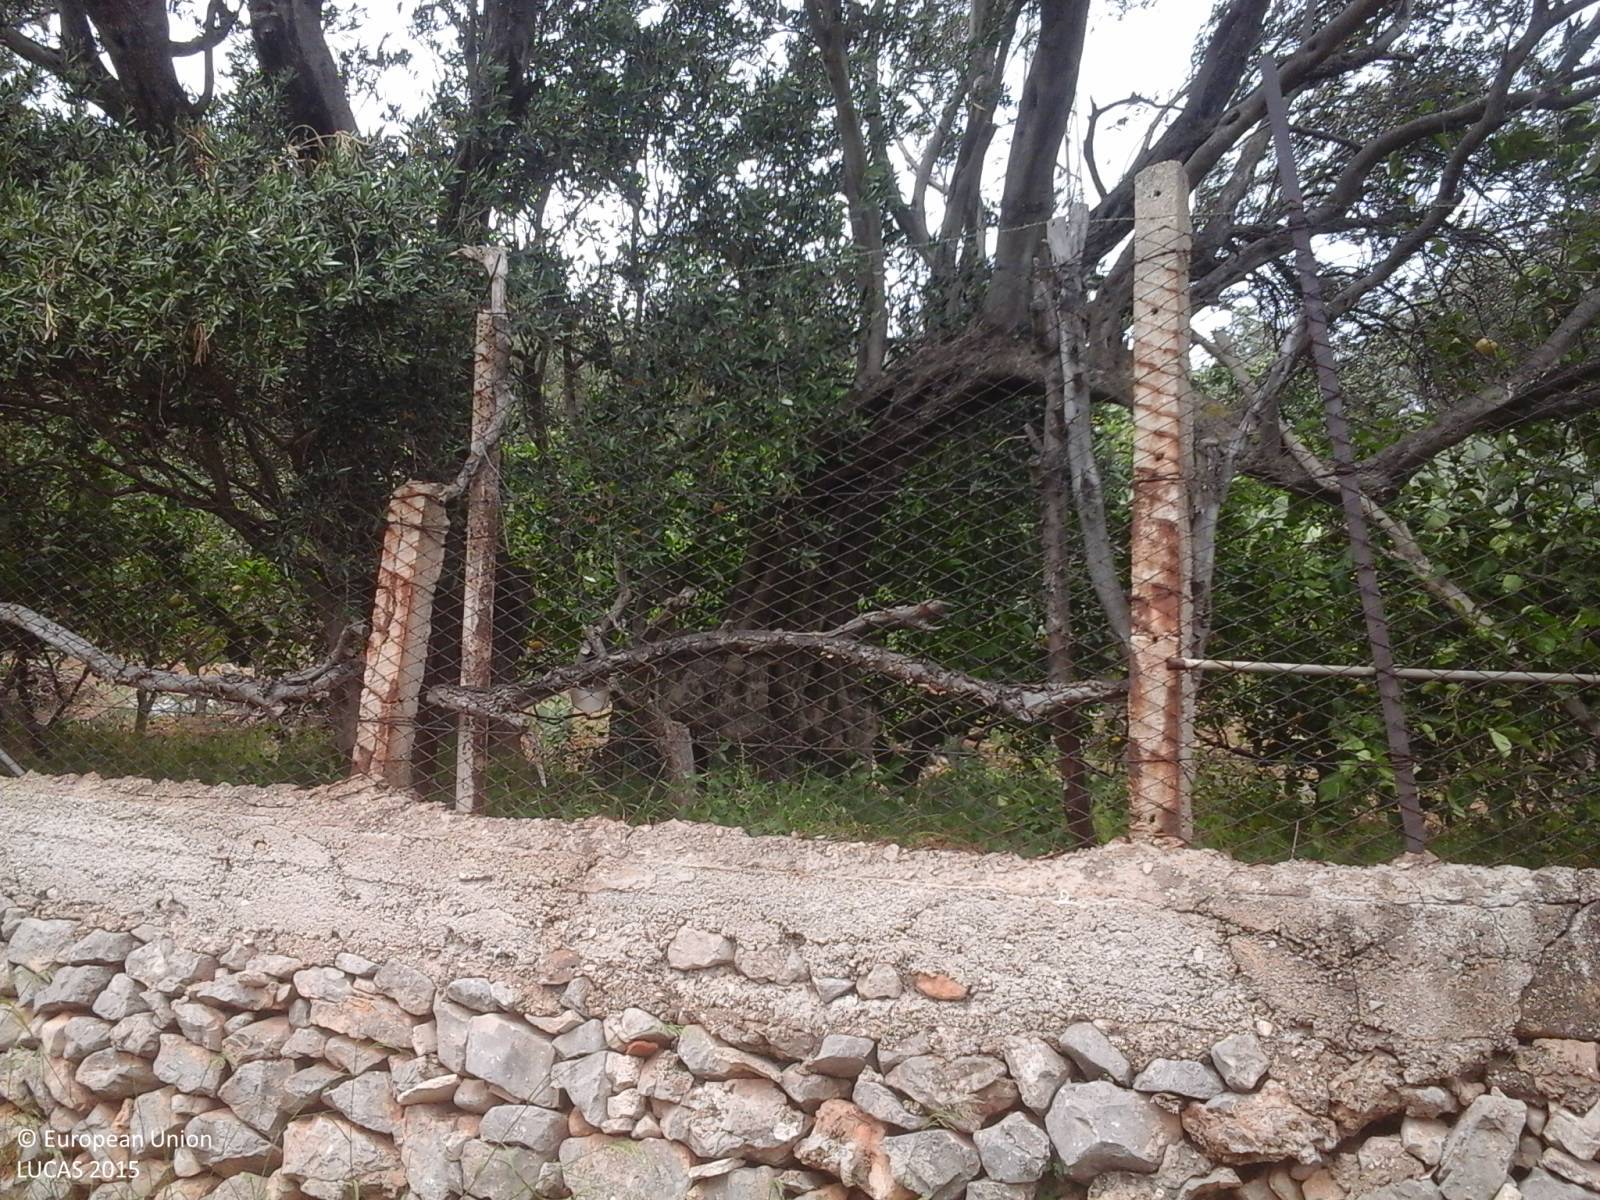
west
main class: Cropland
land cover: Olive groves
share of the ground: 25 - 50 %
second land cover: Spontaneously vegetated surfaces
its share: > 75 %
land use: Agriculture (excluding fallow land and kitchen gardens)
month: May
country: IT
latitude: 38.1490
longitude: 13.1616
